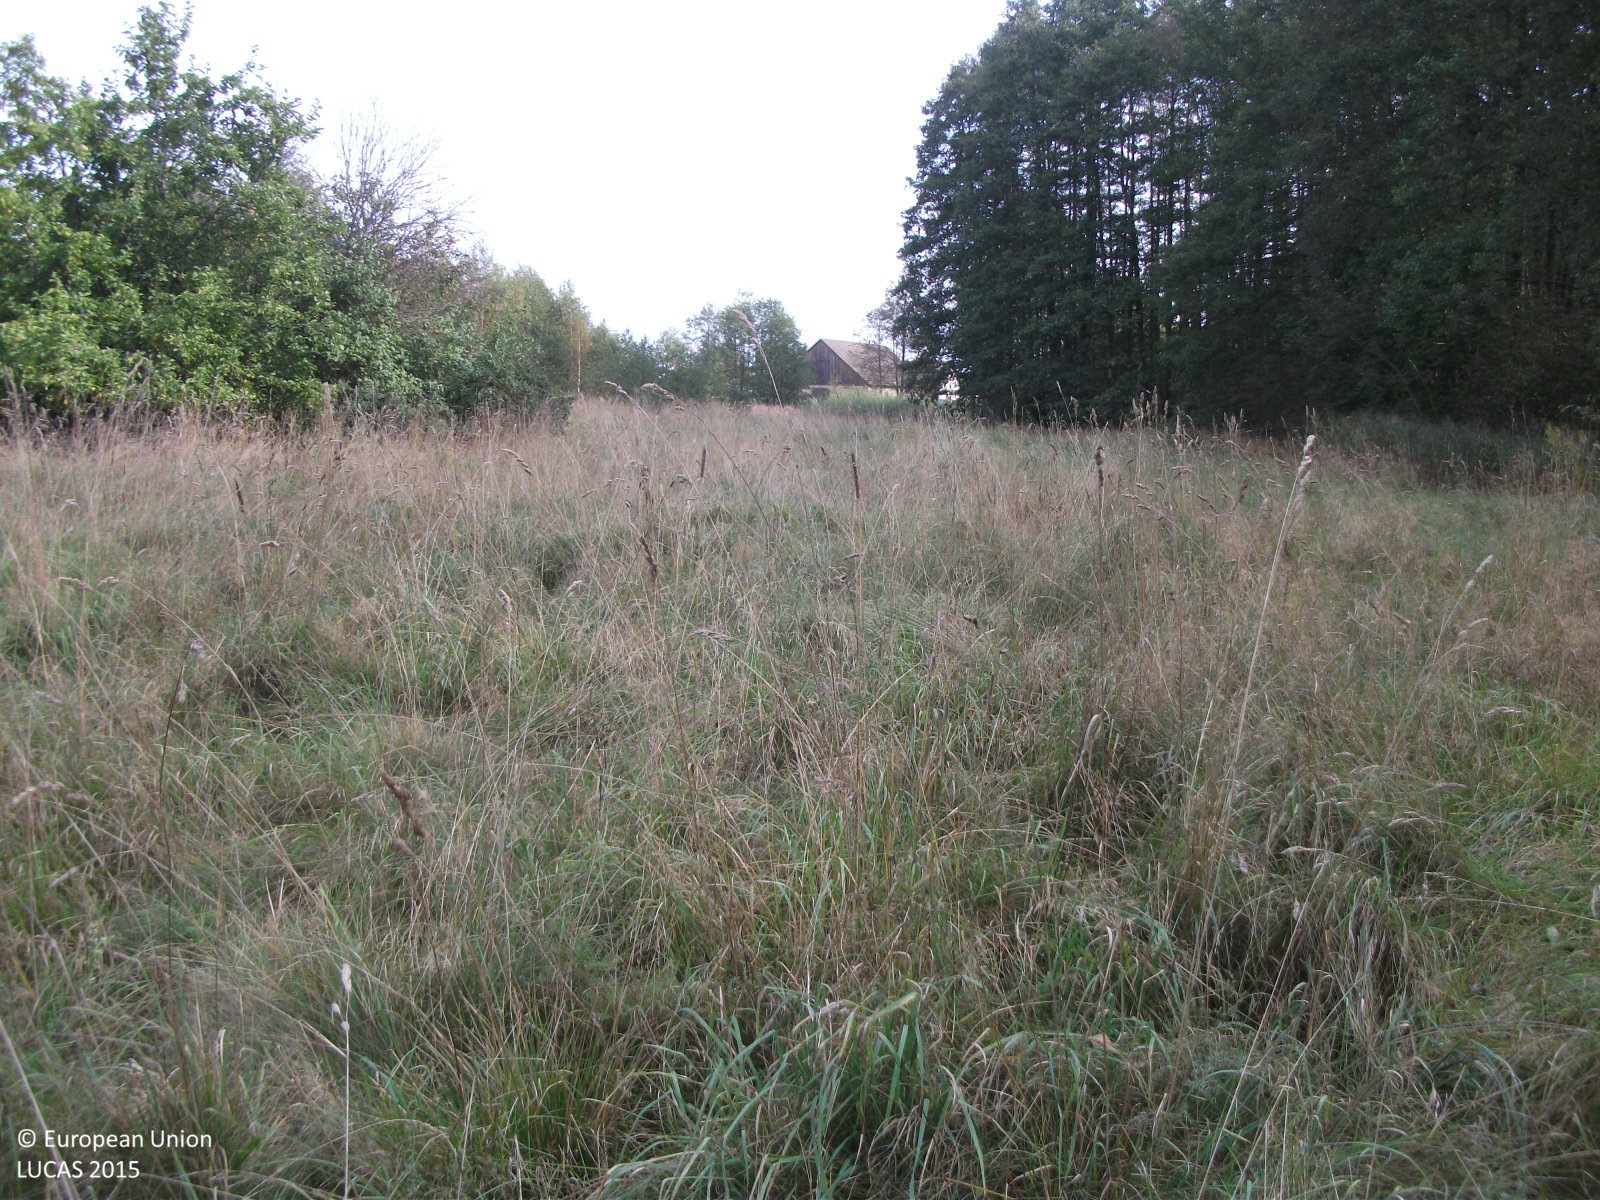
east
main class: Grassland
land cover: Spontaneously vegetated surfaces
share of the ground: > 75 %
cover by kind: herbaceous plants 100 %
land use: Semi-natural and natural areas not in use
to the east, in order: Spontaneously vegetated surfaces; Broadleaved woodland; Ponds and wetlands; Broadleaved woodland; Grassland without tree/shrub cover; Artificial constructions in urban areas; Grassland without tree/shrub cover
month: September
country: LV
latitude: 57.6168
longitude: 24.6070
